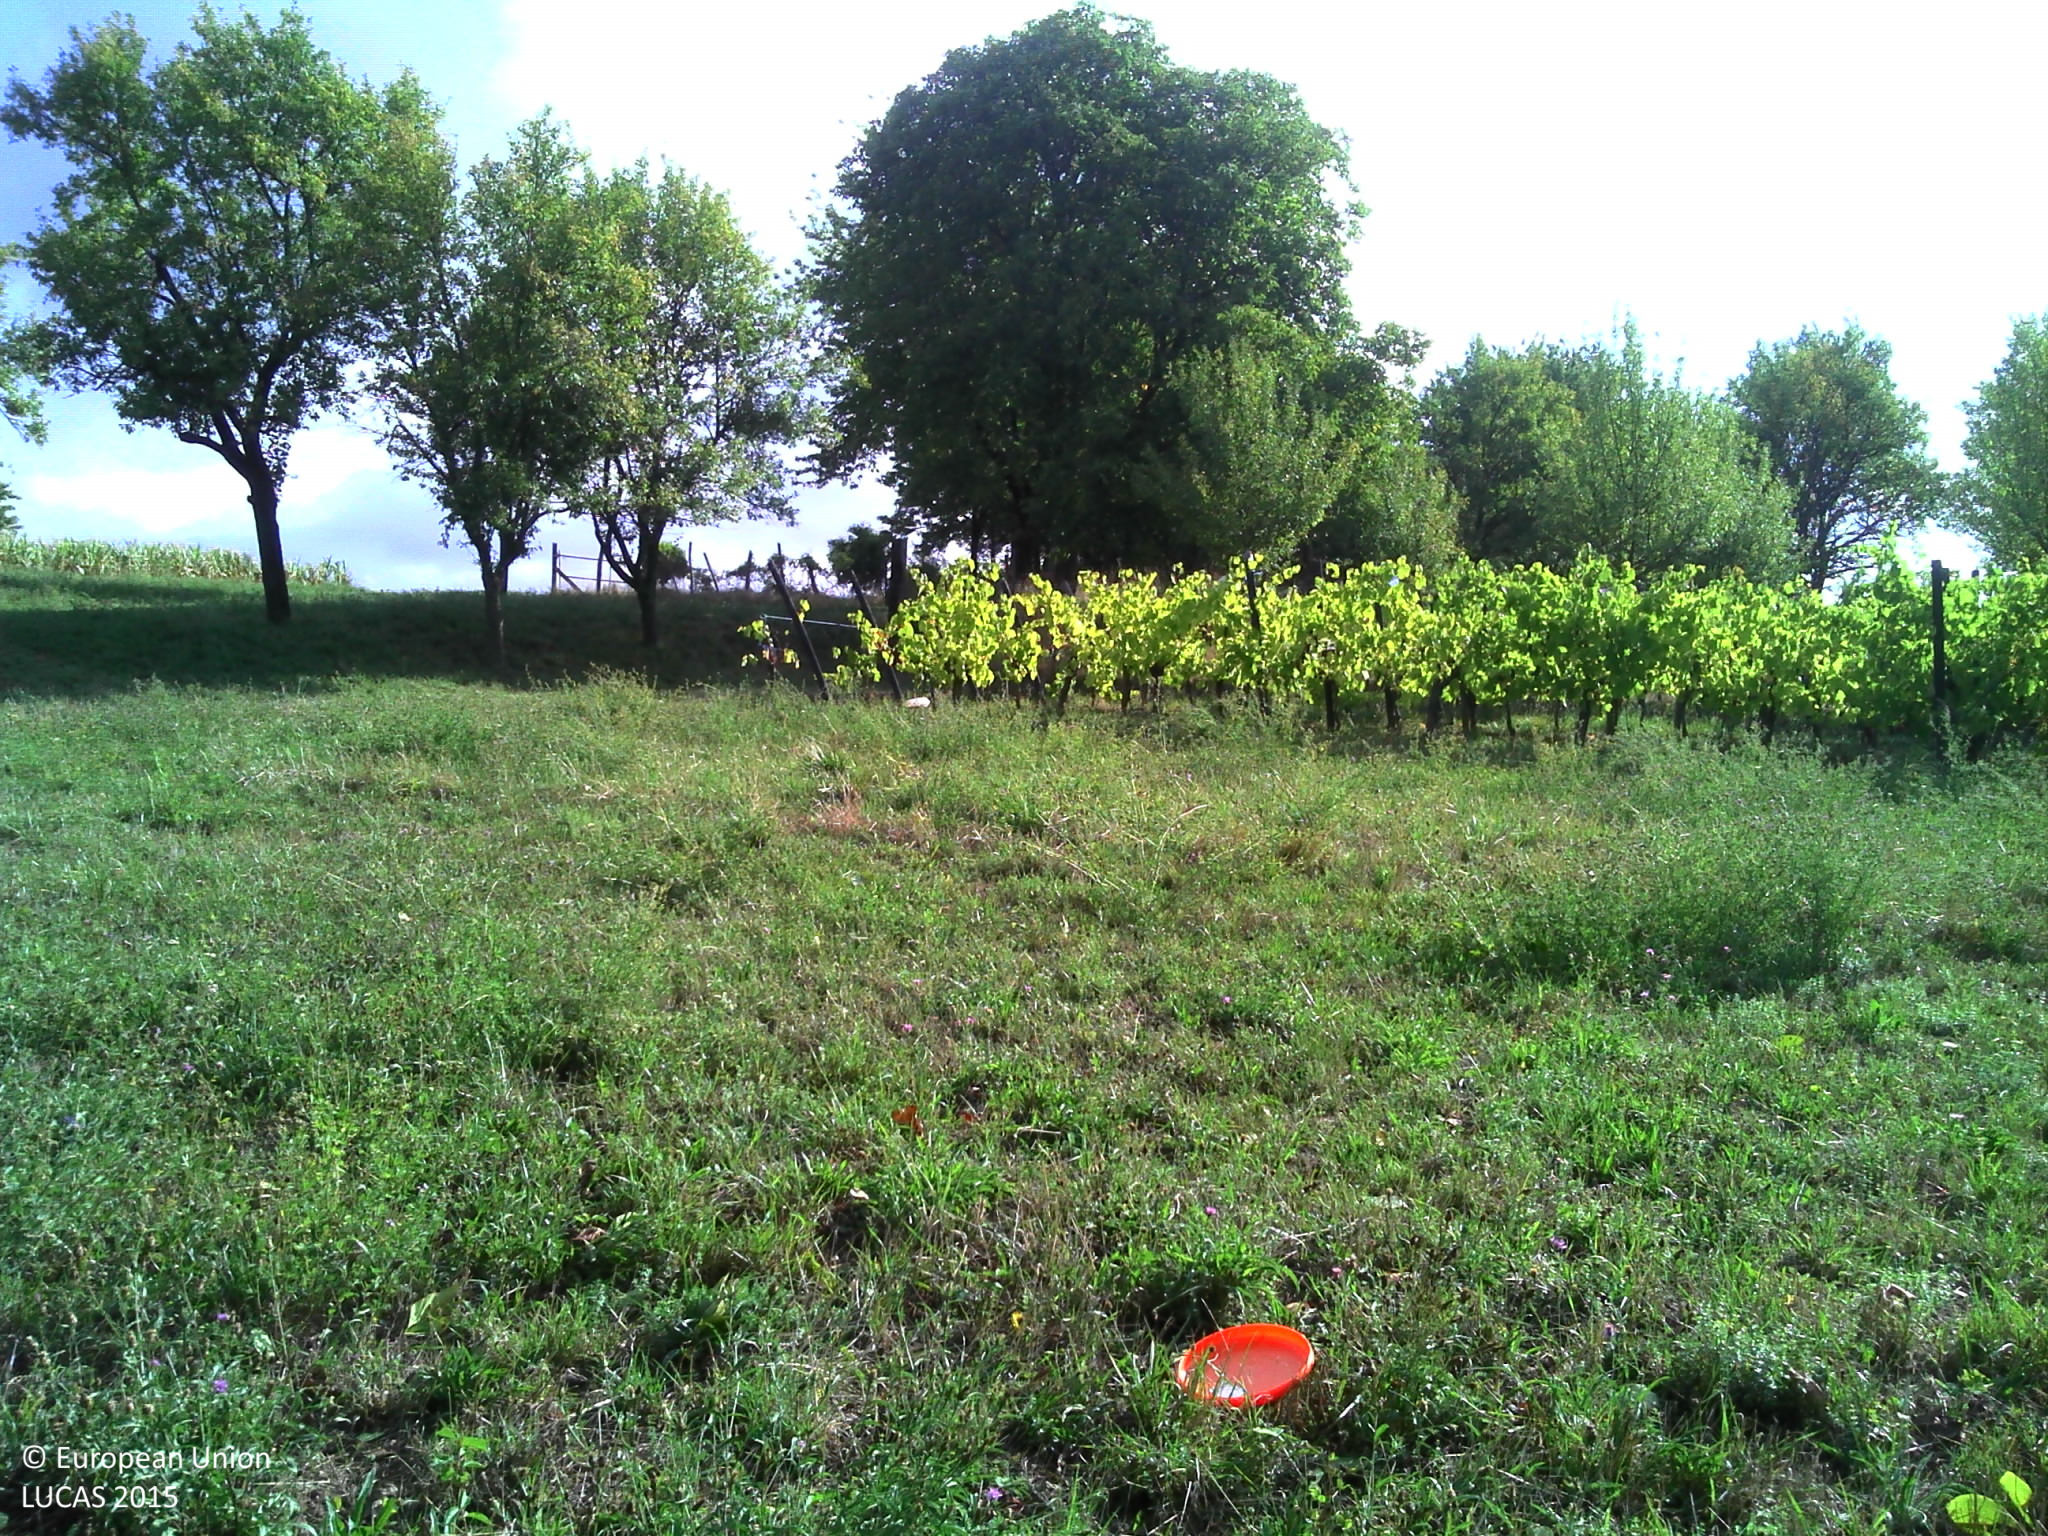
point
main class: Grassland
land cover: Grassland without tree/shrub cover
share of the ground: > 75 %
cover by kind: herbaceous plants 100 %
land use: Agriculture (excluding fallow land and kitchen gardens)
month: August
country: FR
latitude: 48.8092
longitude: 7.5905
